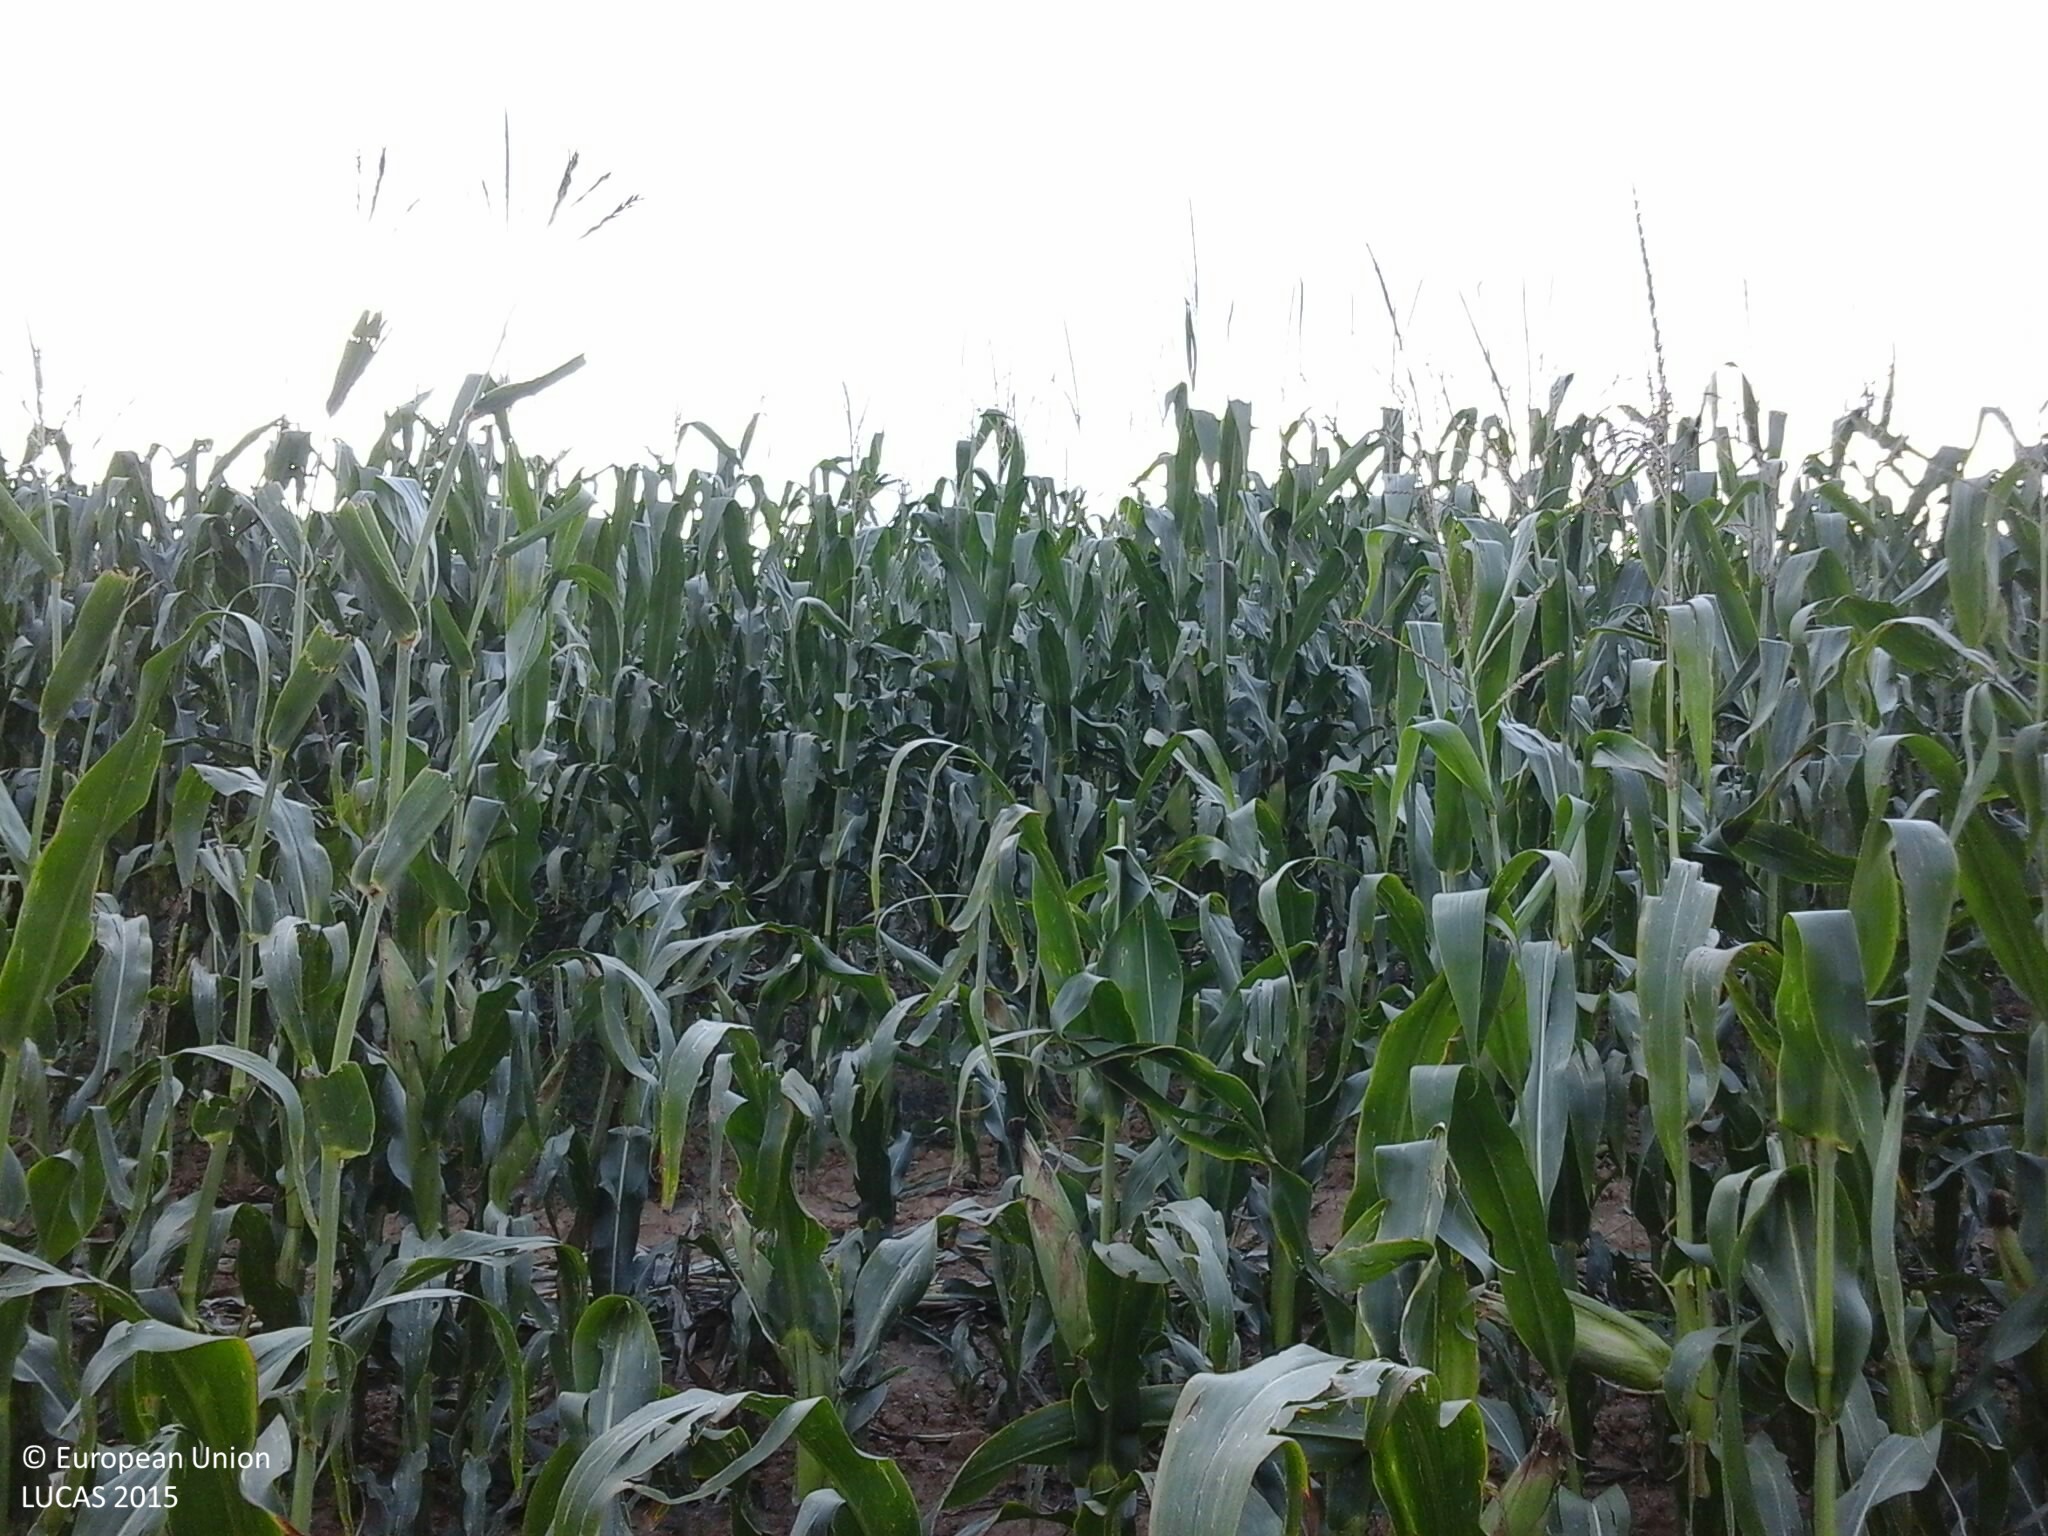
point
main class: Cropland
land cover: Maize
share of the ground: > 75 %
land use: Agriculture (excluding fallow land and kitchen gardens)
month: August
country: HU
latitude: 45.9734
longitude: 18.3059
